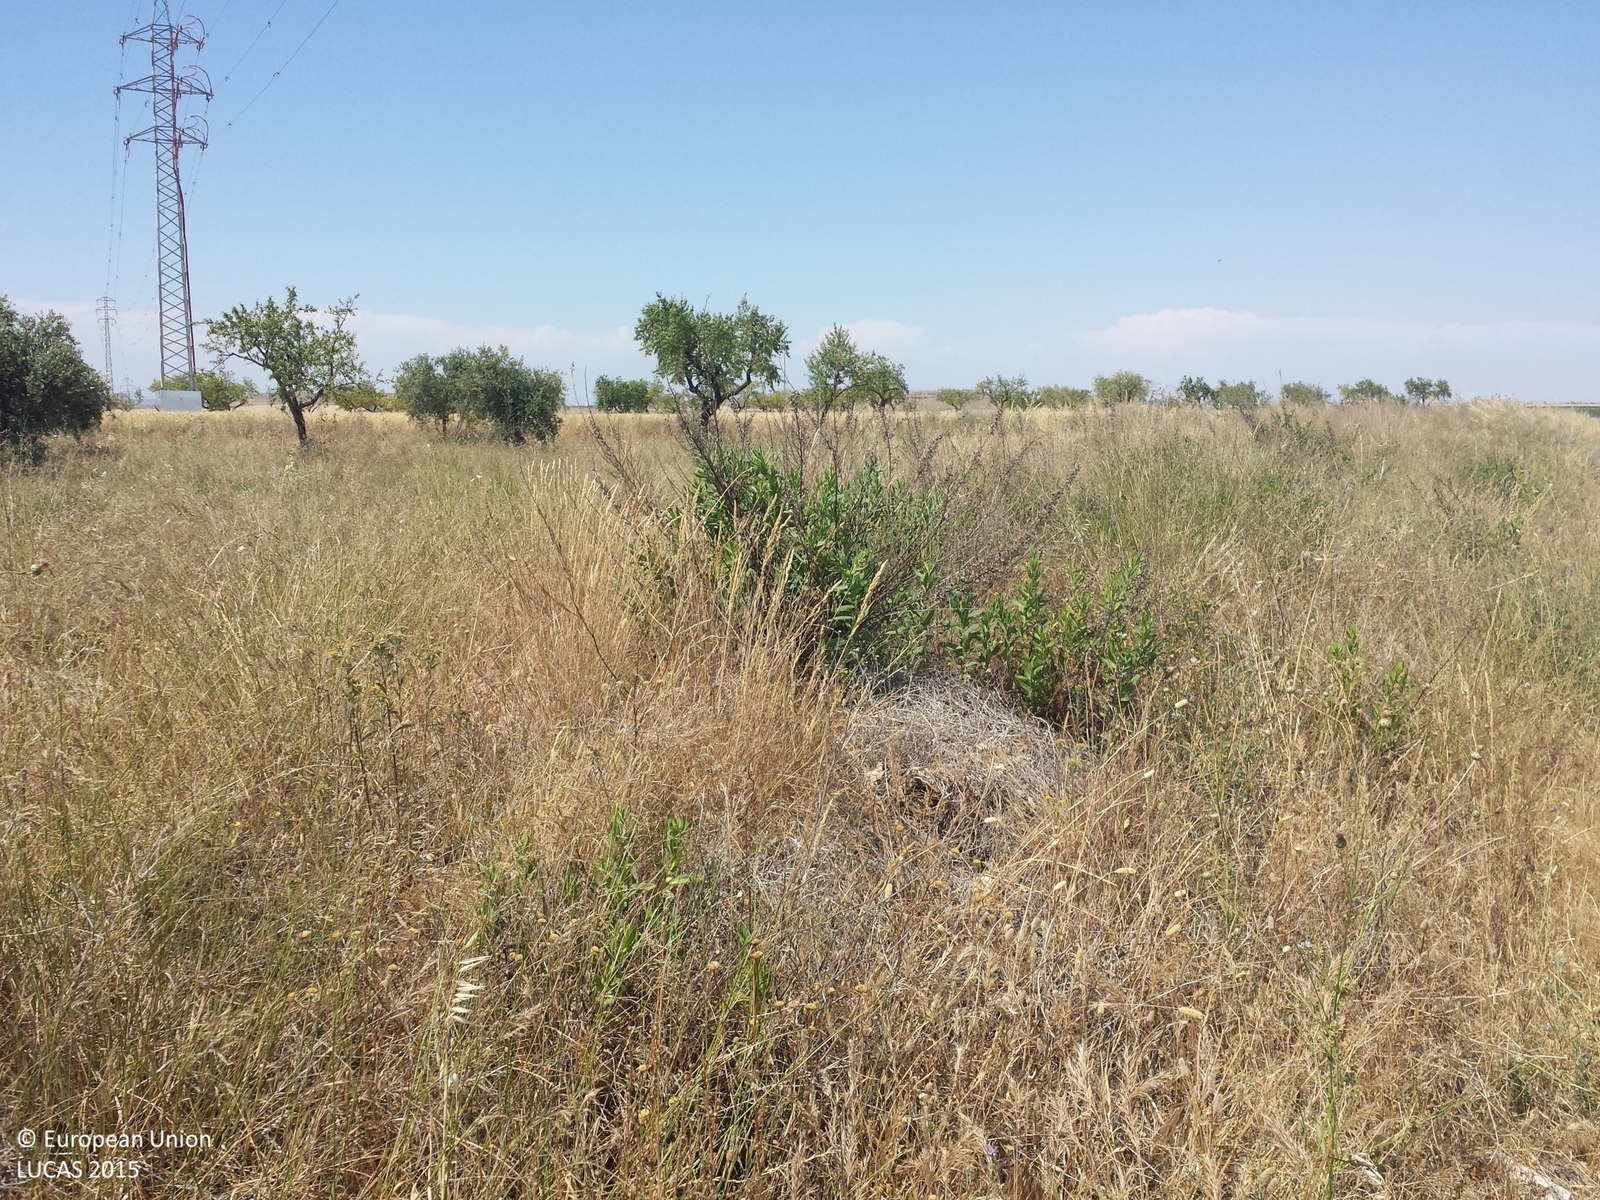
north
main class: Grassland
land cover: Grassland without tree/shrub cover
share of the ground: 50 - 75 %
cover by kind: herbaceous plants 60 %, unconsolidated bare surface 30 %, shrubs 5 %, consolidated bare surface 5 %
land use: Road transport
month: May
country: ES
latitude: 41.4899
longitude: 0.6101
